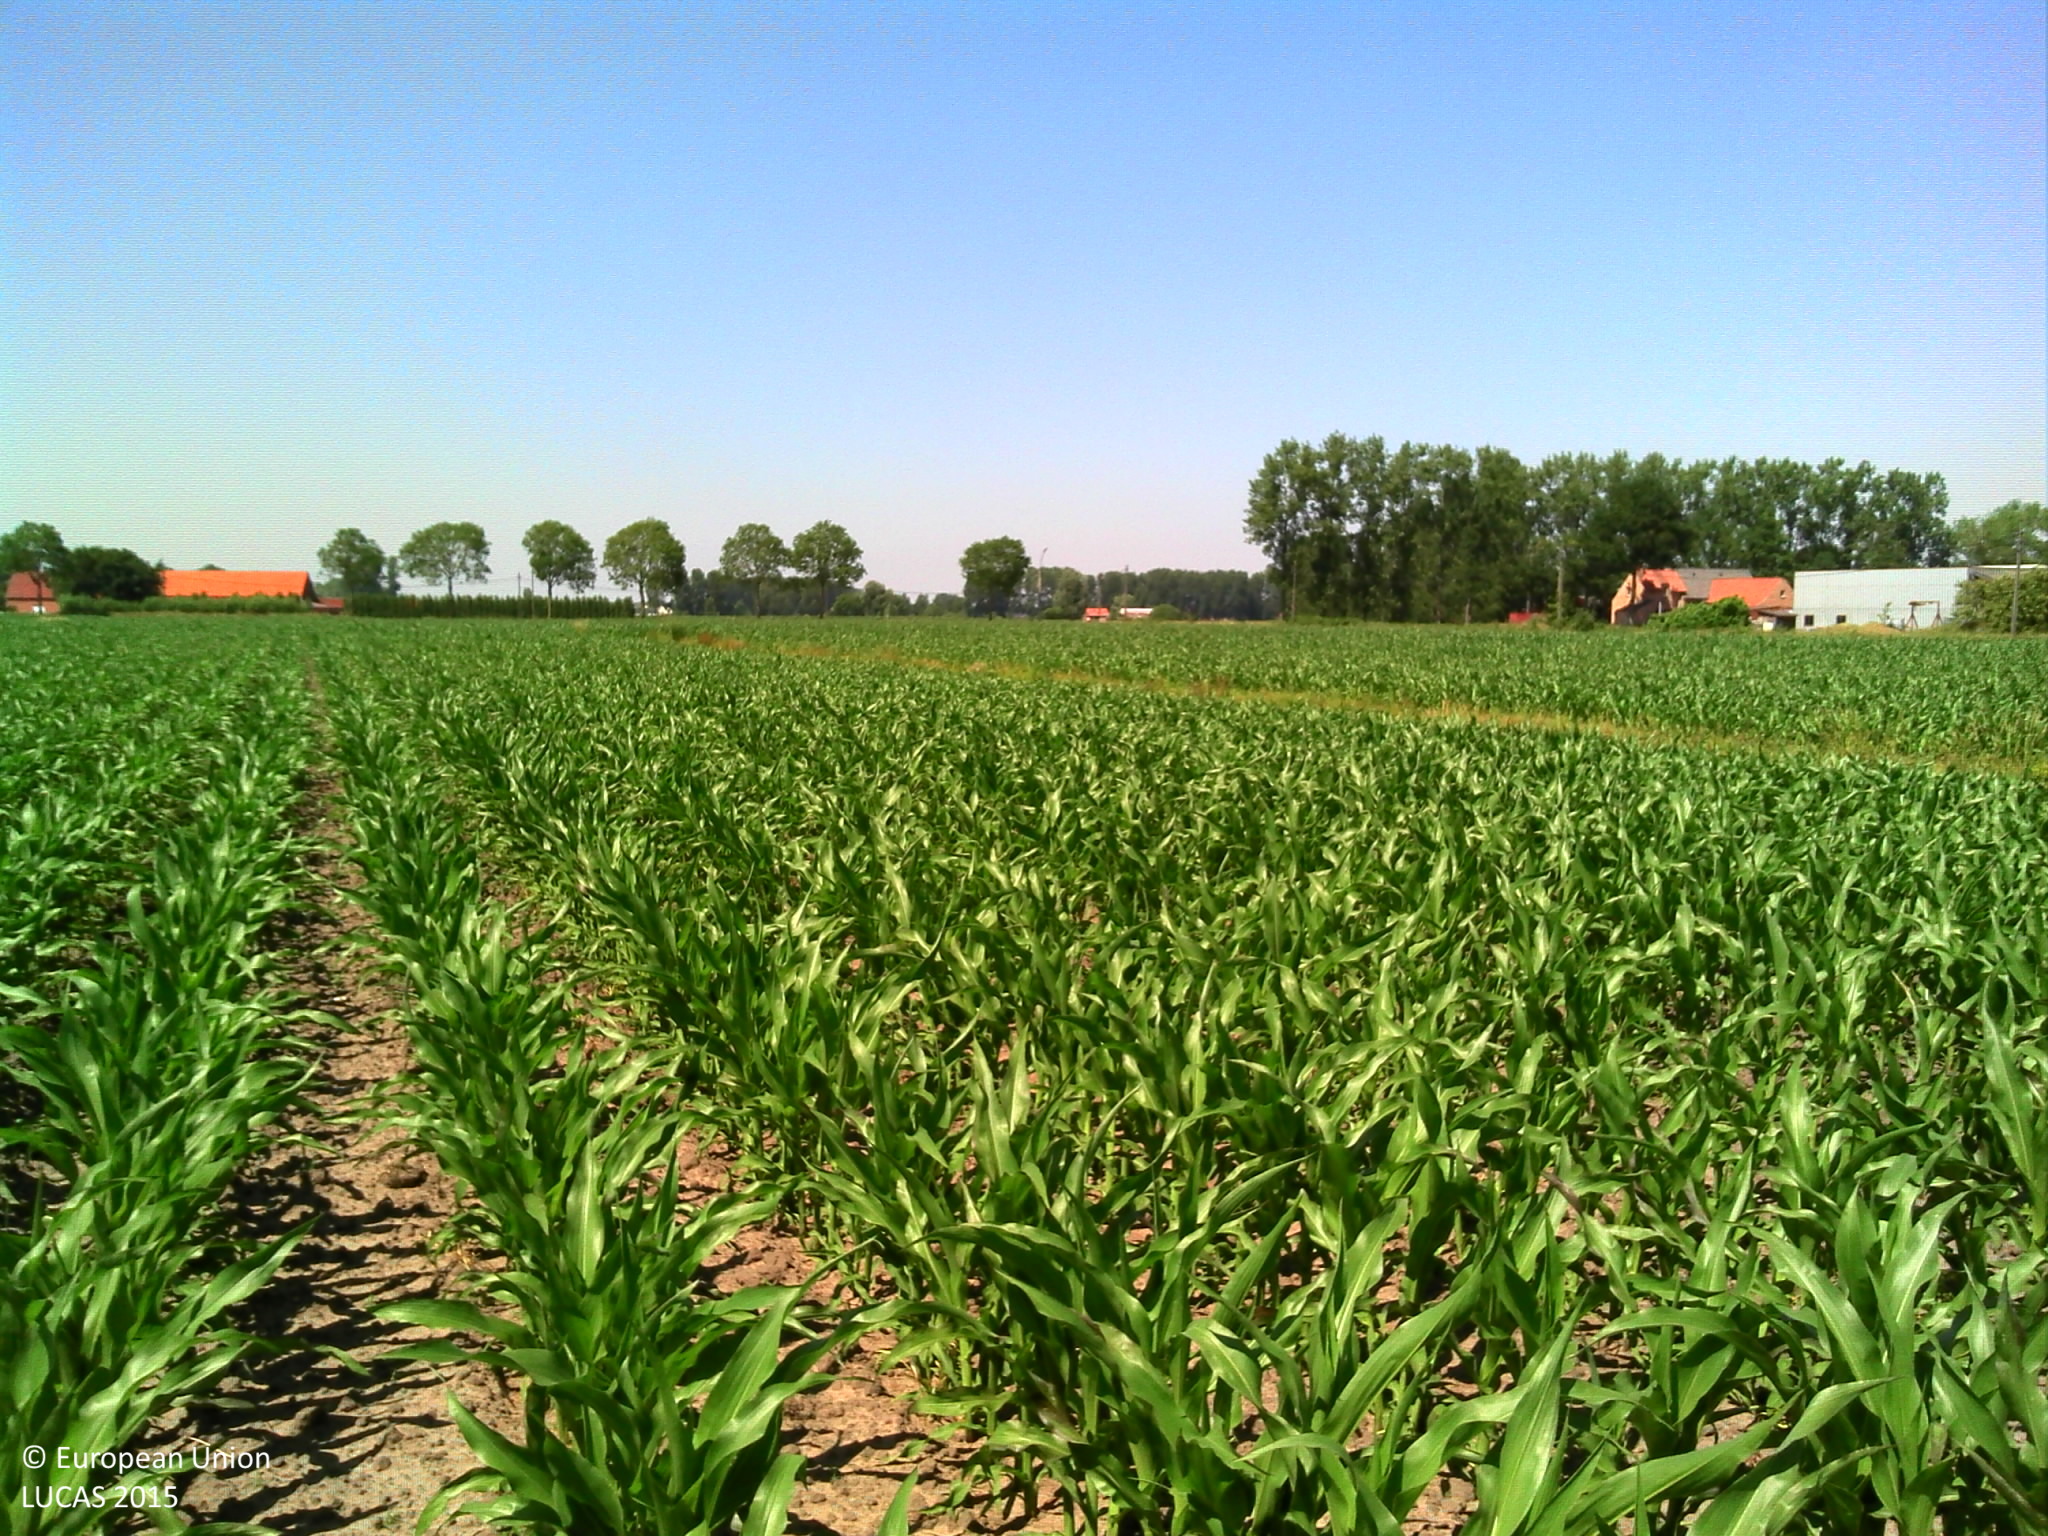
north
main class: Cropland
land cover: Maize
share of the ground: > 75 %
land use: Agriculture (excluding fallow land and kitchen gardens)
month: June
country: BE
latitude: 51.2157
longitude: 3.6506
